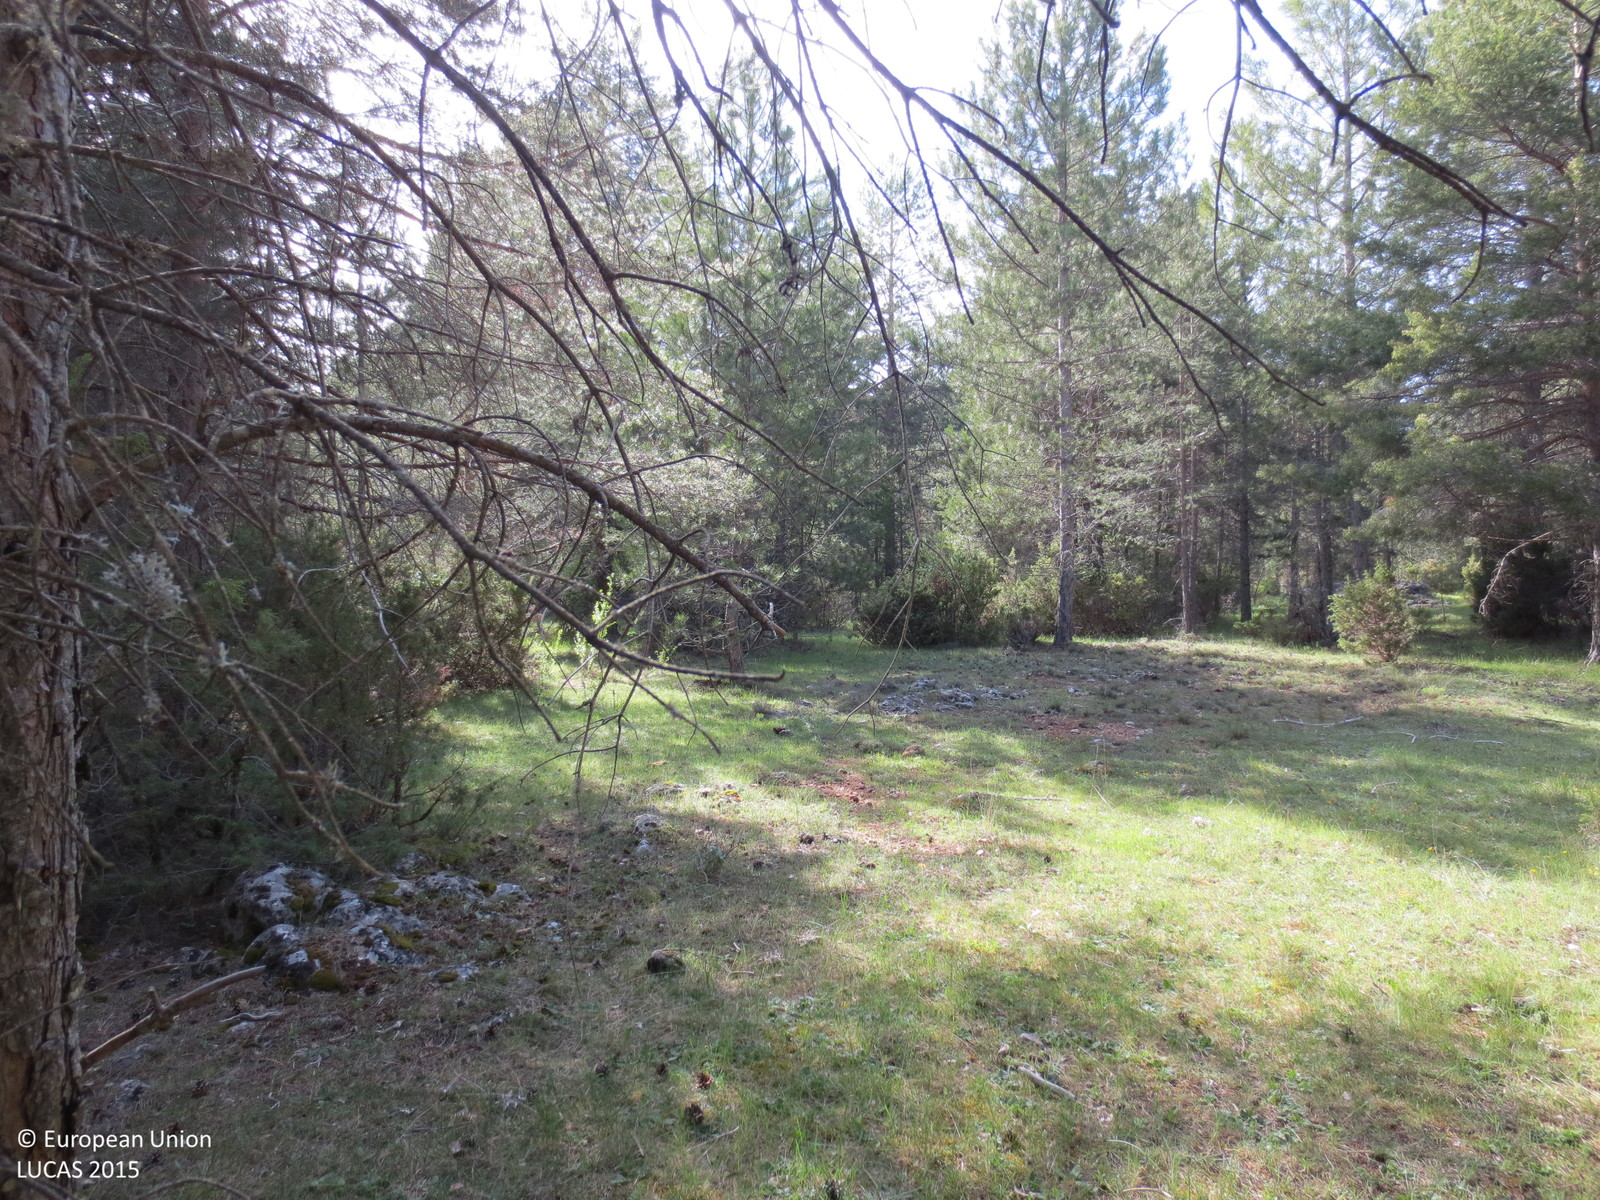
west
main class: Woodland
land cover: Pine dominated coniferous woodland
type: coniferous forest of the mediterranean region
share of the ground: 50 - 75 %
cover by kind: coniferous forest trees 60 %, shrubs 20 %, herbaceous plants 20 %
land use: Forestry
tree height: > 5 m
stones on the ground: > 50 %
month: May
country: ES
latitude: 40.4552
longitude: -2.0353
